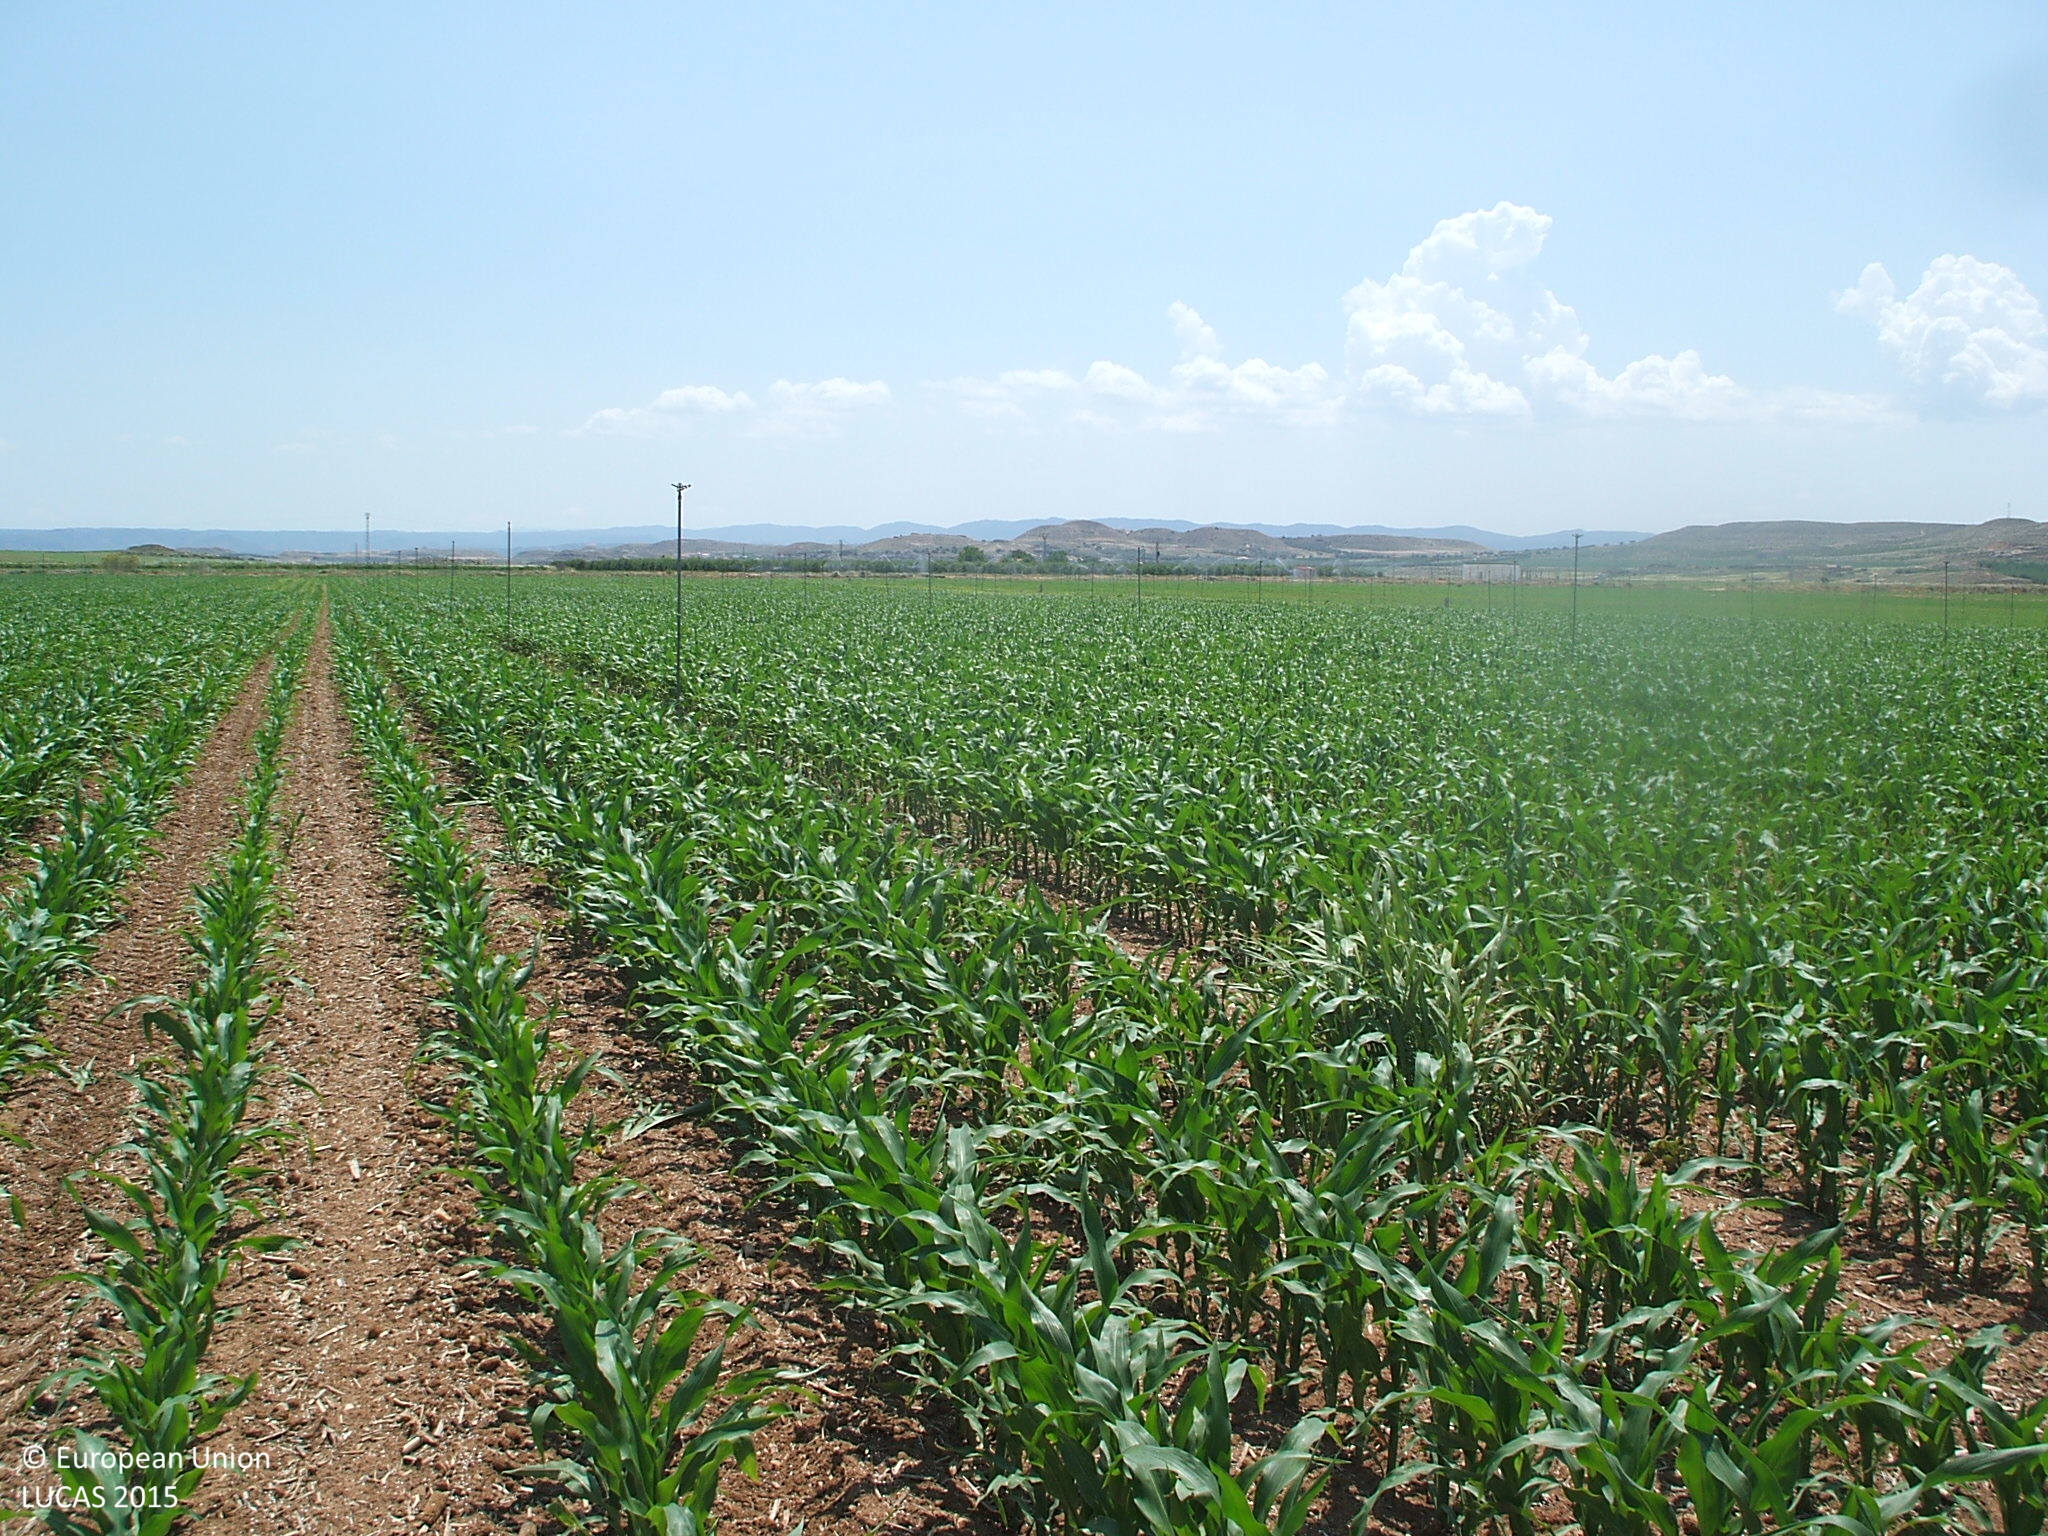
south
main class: Cropland
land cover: Maize
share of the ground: 50 - 75 %
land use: Agriculture (excluding fallow land and kitchen gardens)
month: June
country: ES
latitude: 41.0273
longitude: -0.2042
